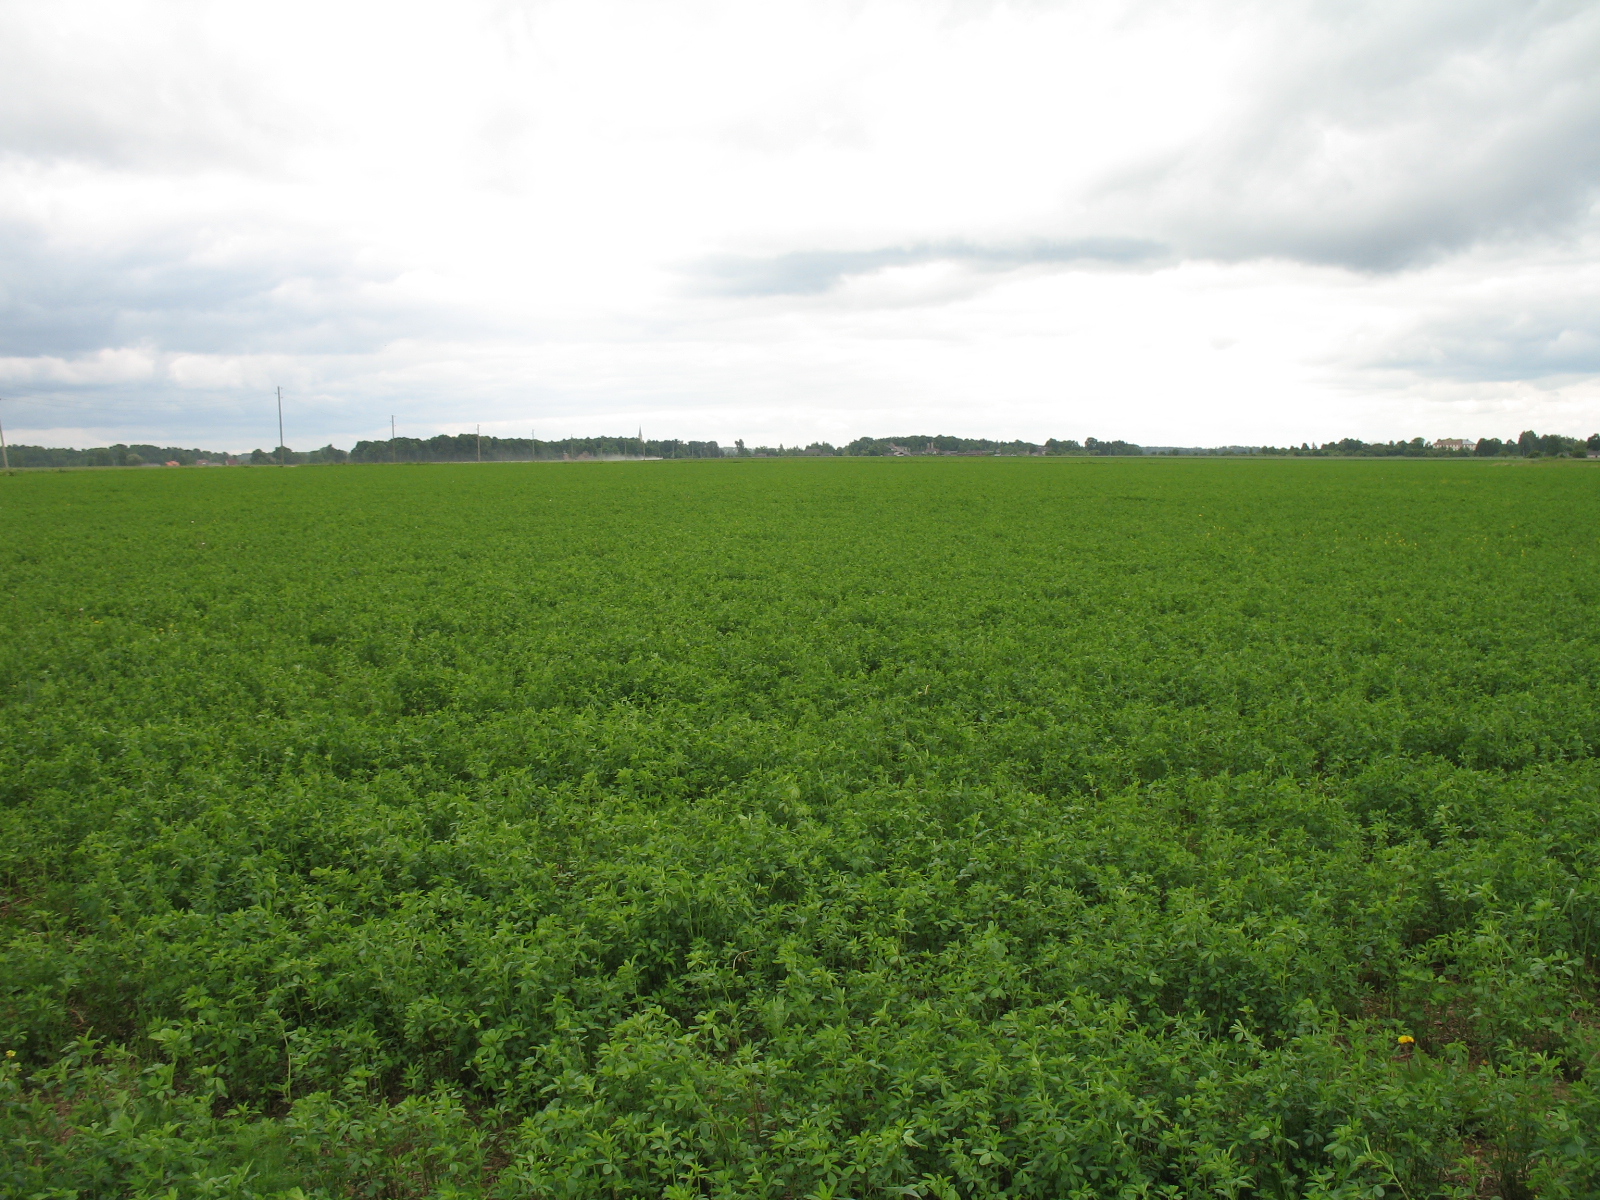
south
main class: Cropland
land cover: Lucerne
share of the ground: > 75 %
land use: Agriculture (excluding fallow land and kitchen gardens)
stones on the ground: < 10 %
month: June
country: LV
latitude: 56.5480
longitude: 23.4941
